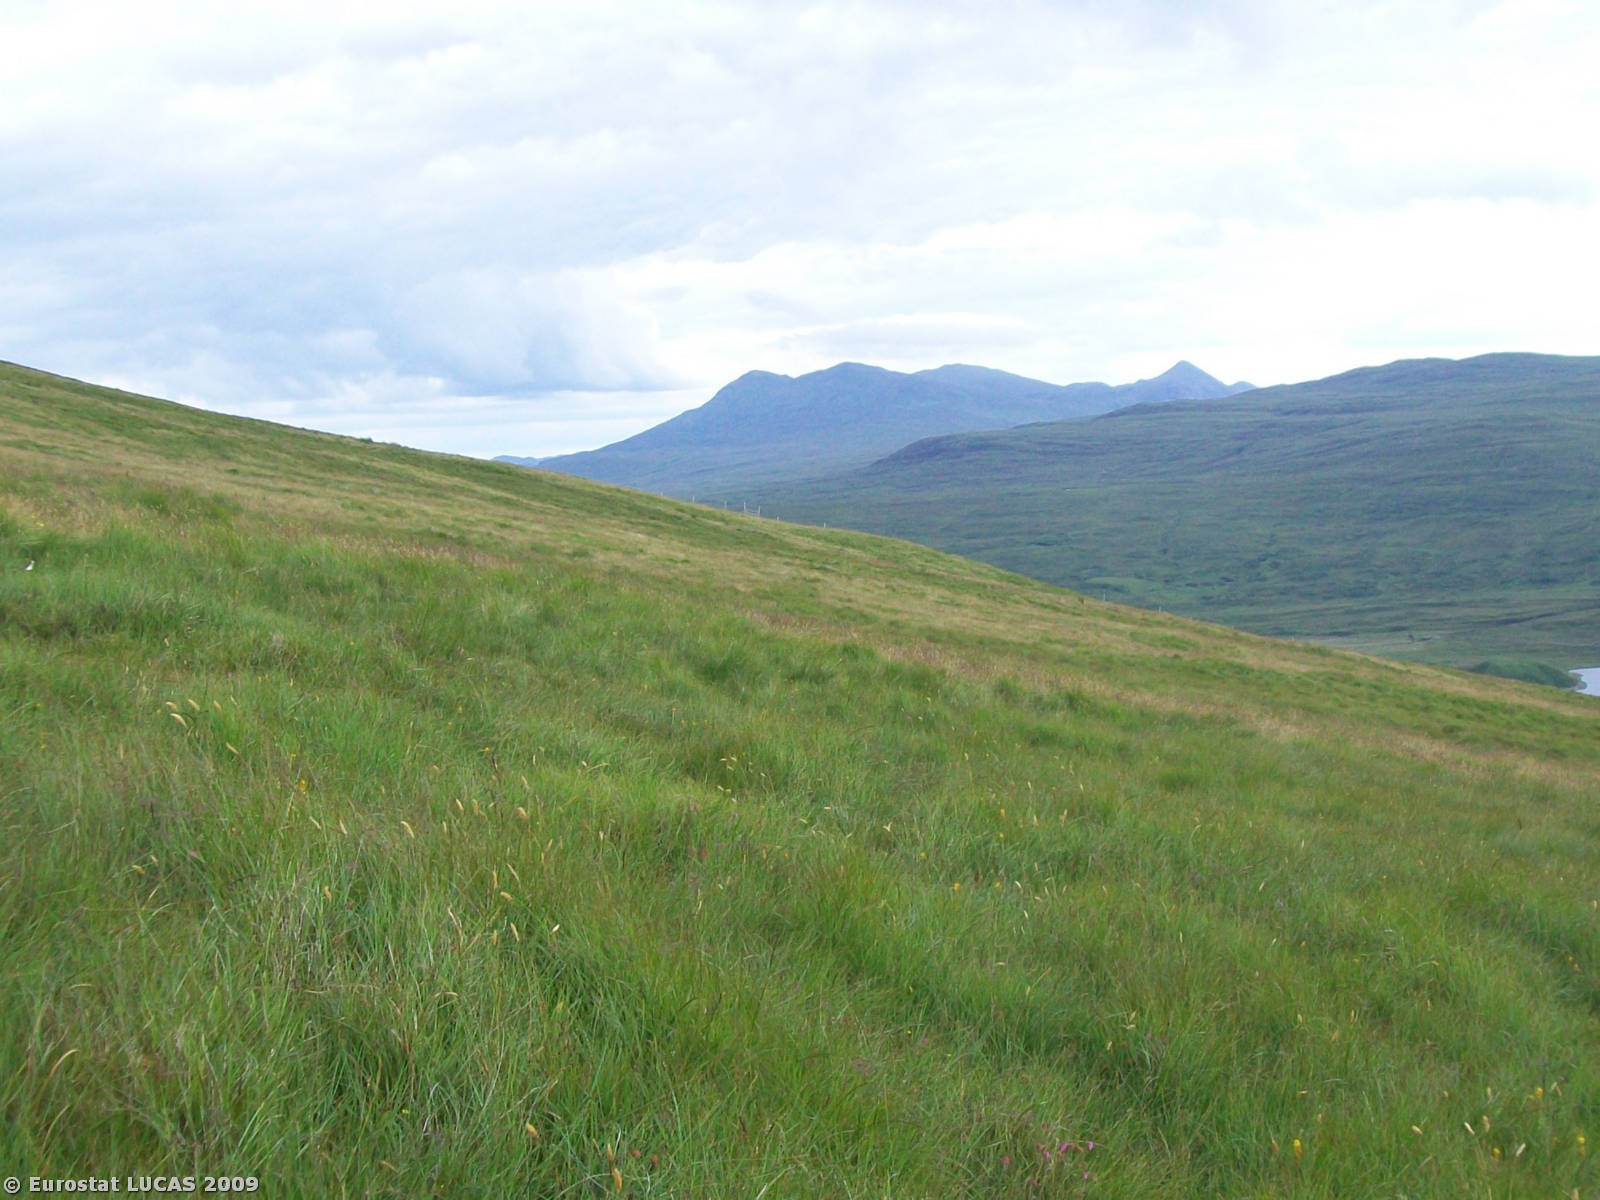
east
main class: Grassland
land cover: Grassland without tree/shrub cover
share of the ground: > 75 %
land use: Agriculture (excluding fallow land and kitchen gardens)
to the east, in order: Grassland without tree/shrub cover; Rivers and streams; Grassland without tree/shrub cover; Rivers and streams; Grassland without tree/shrub cover
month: July
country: GB
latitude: 57.5573
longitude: -5.1308
